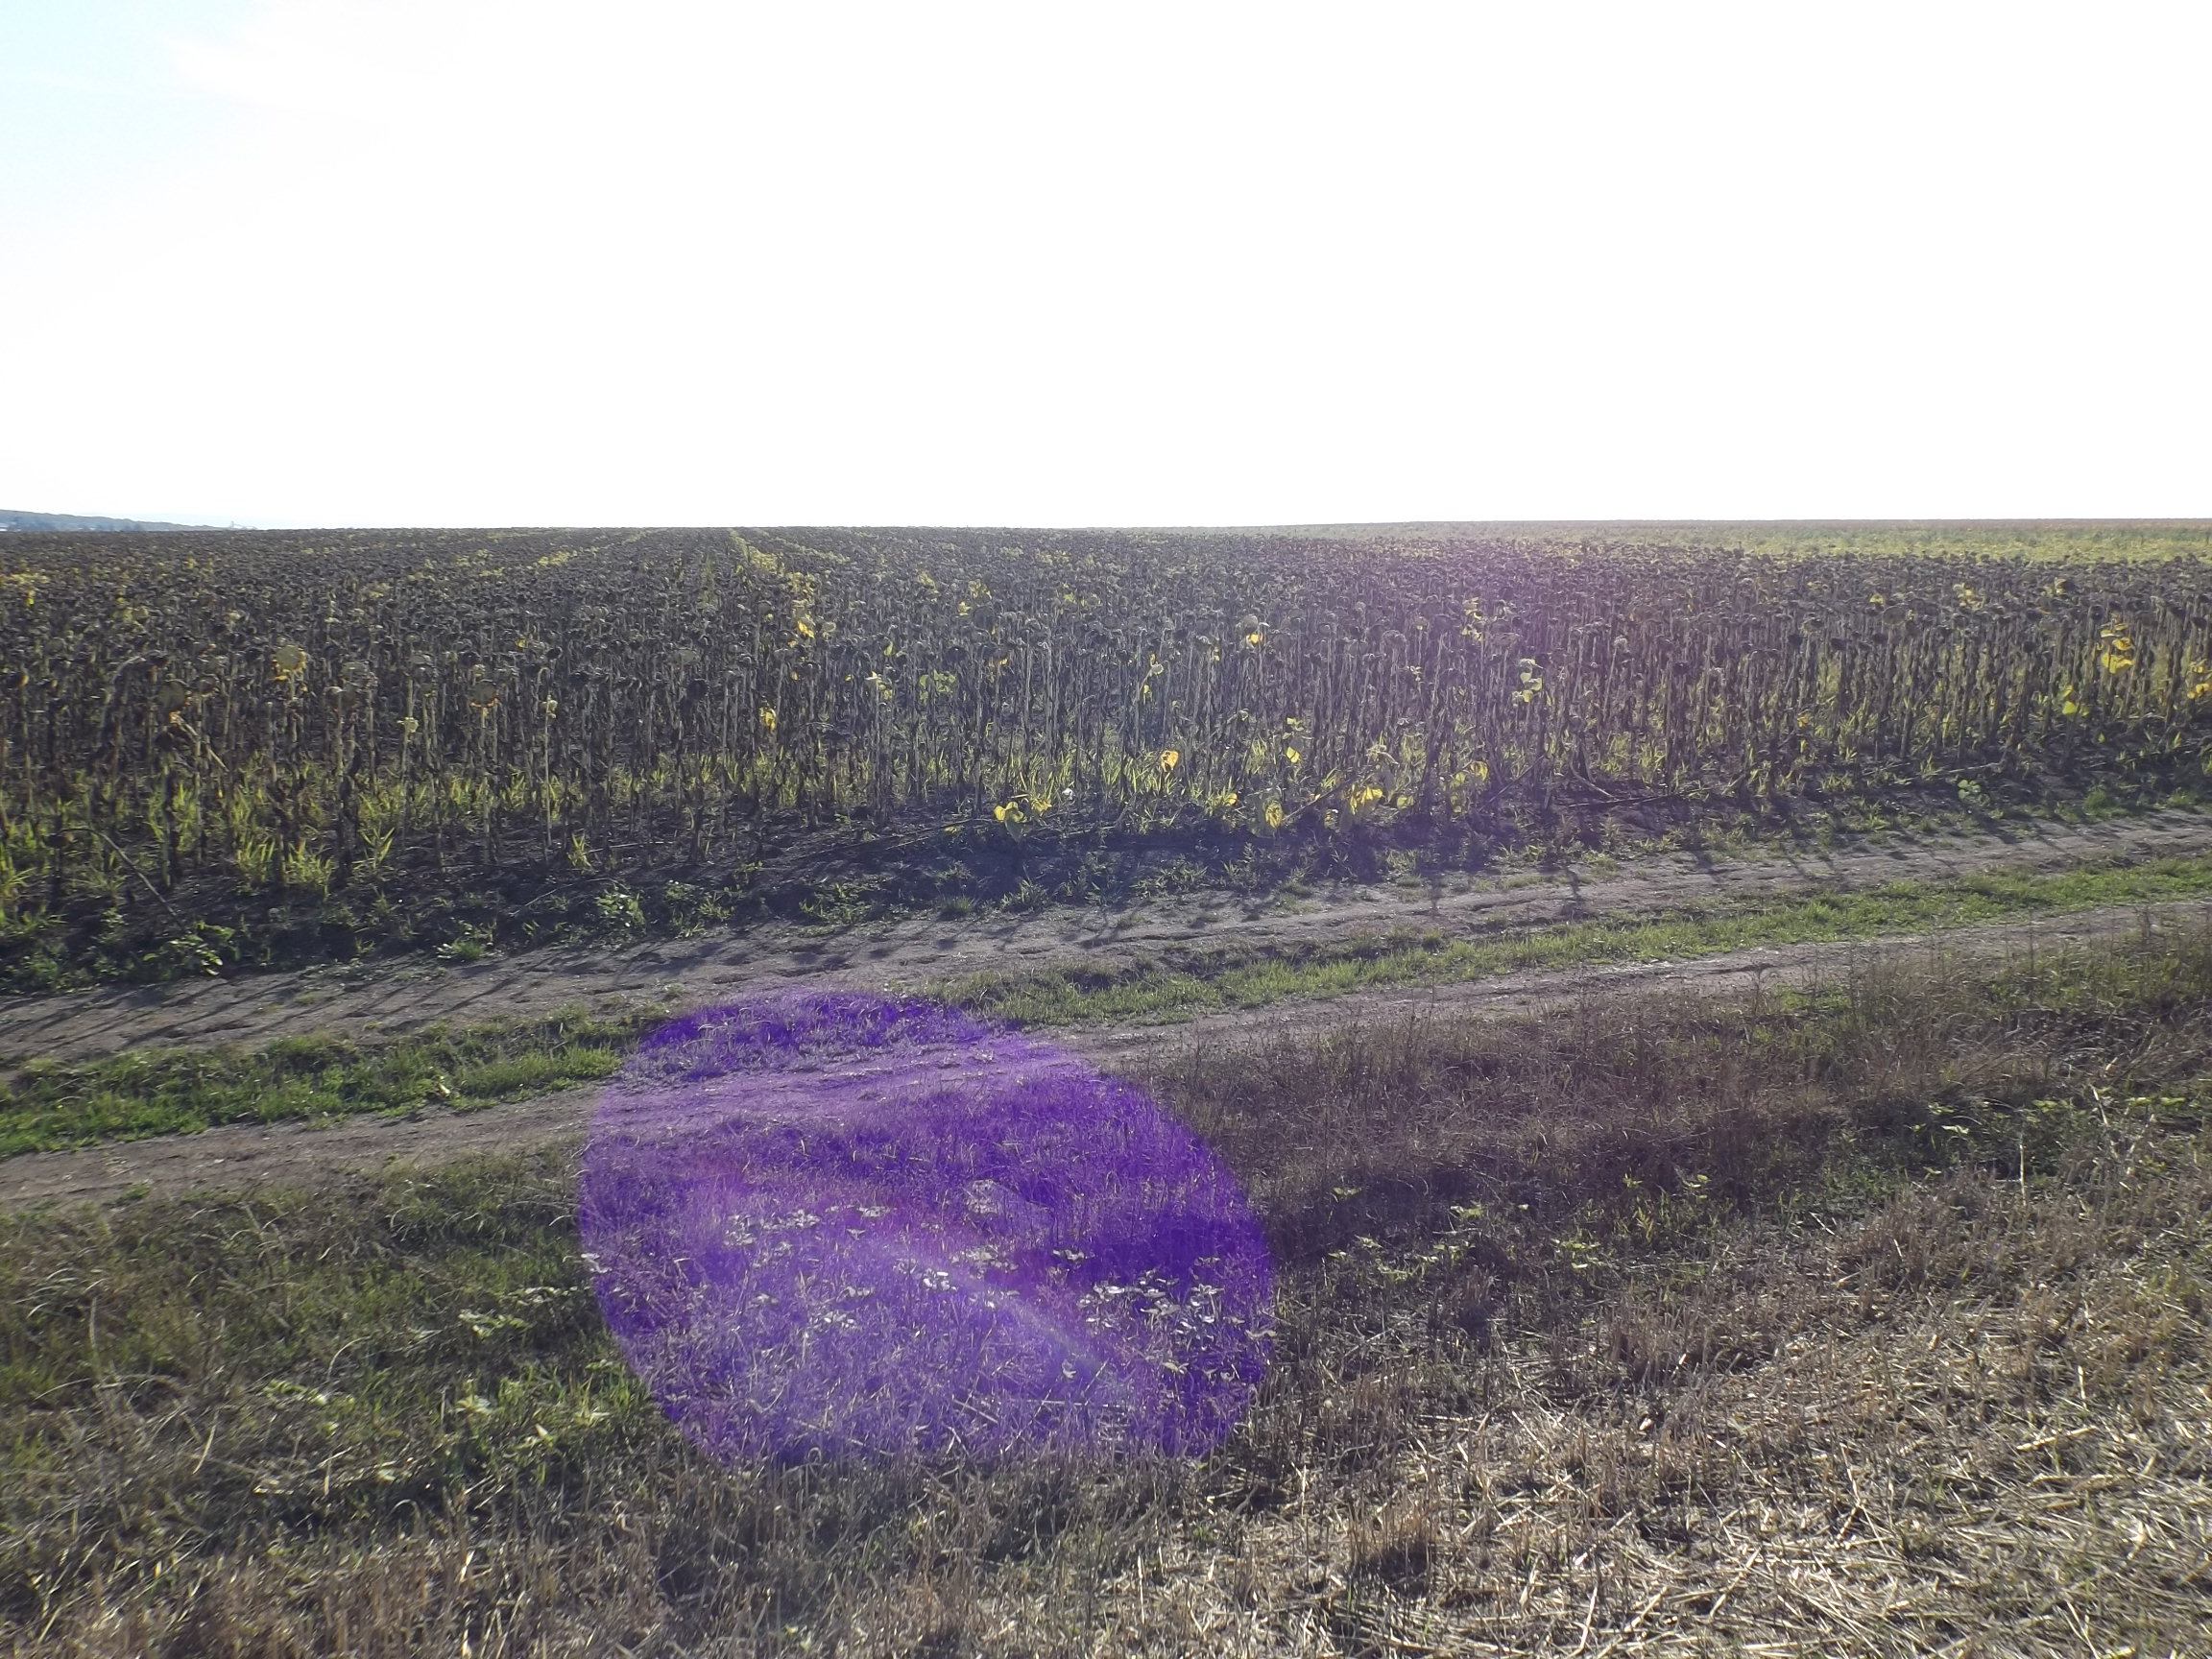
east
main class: Cropland
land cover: Common wheat
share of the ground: 25 - 50 %
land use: Agriculture (excluding fallow land and kitchen gardens)
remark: Harvested field
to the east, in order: Common wheat; Grass margins; Tracks; Sunflower; Other fresh vegetables; Spontaneously vegetated surfaces
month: August
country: BG
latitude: 43.3973
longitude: 27.5268
